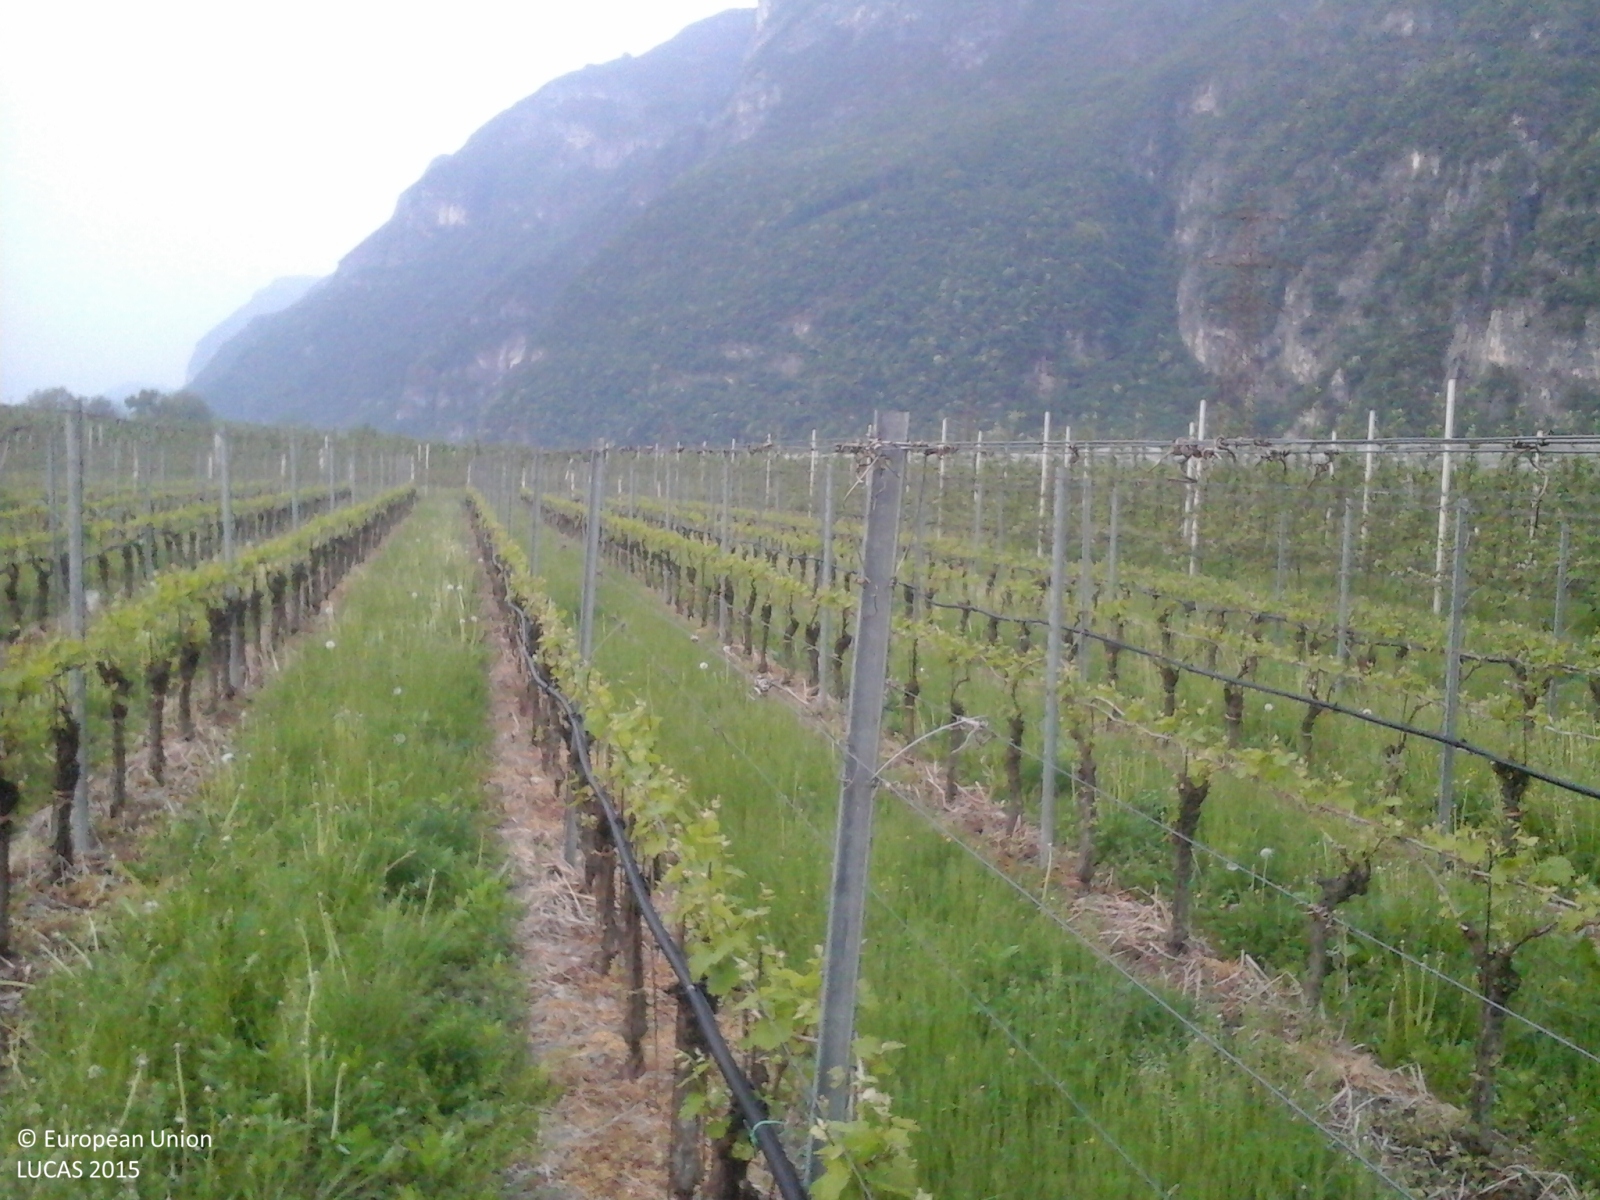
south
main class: Cropland
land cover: Vineyards
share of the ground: < 10 %
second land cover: Grassland without tree/shrub cover
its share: > 75 %
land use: Agriculture (excluding fallow land and kitchen gardens)
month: April
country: IT
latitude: 46.1477
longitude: 11.0731
